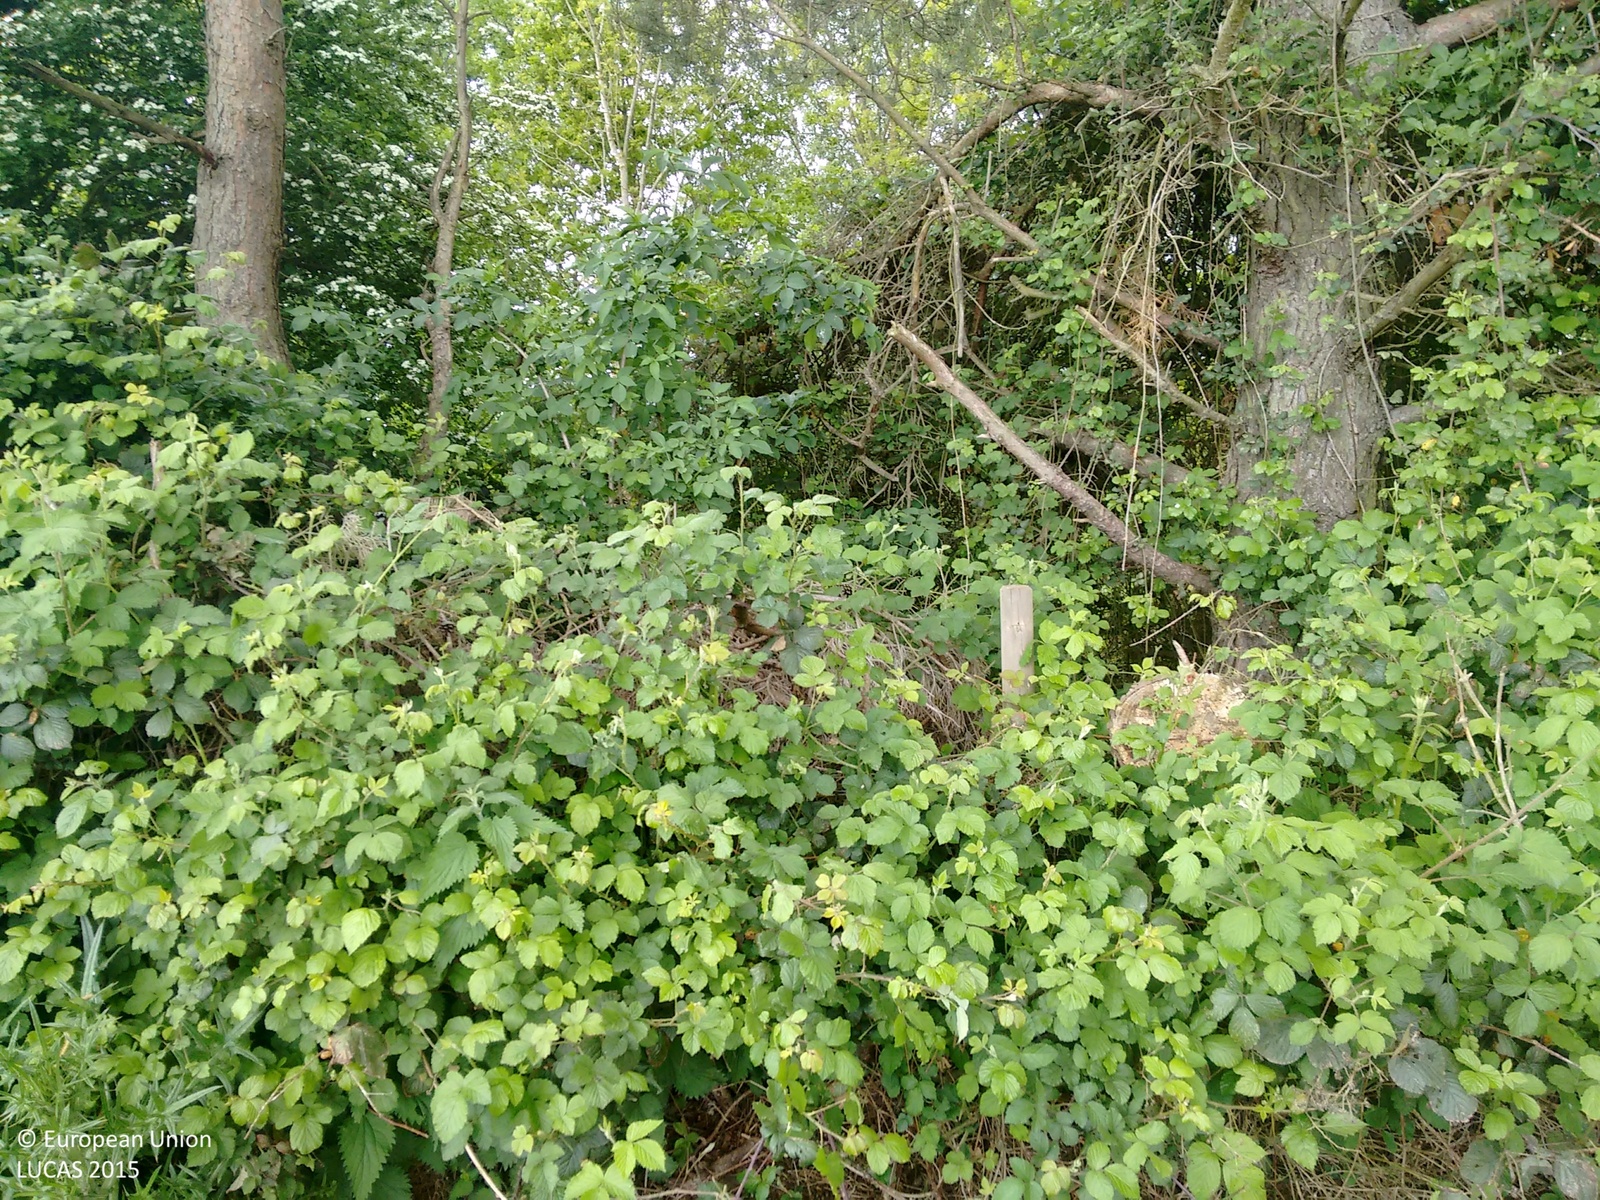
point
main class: Woodland
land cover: Broadleaved woodland
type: mesophytic deciduous forest
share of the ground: > 75 %
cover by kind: broadleaved forest trees 80 %, shrubs 20 %
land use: Semi-natural and natural areas not in use
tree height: > 5 m
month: May
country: GB
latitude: 51.2030
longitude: 0.7717
